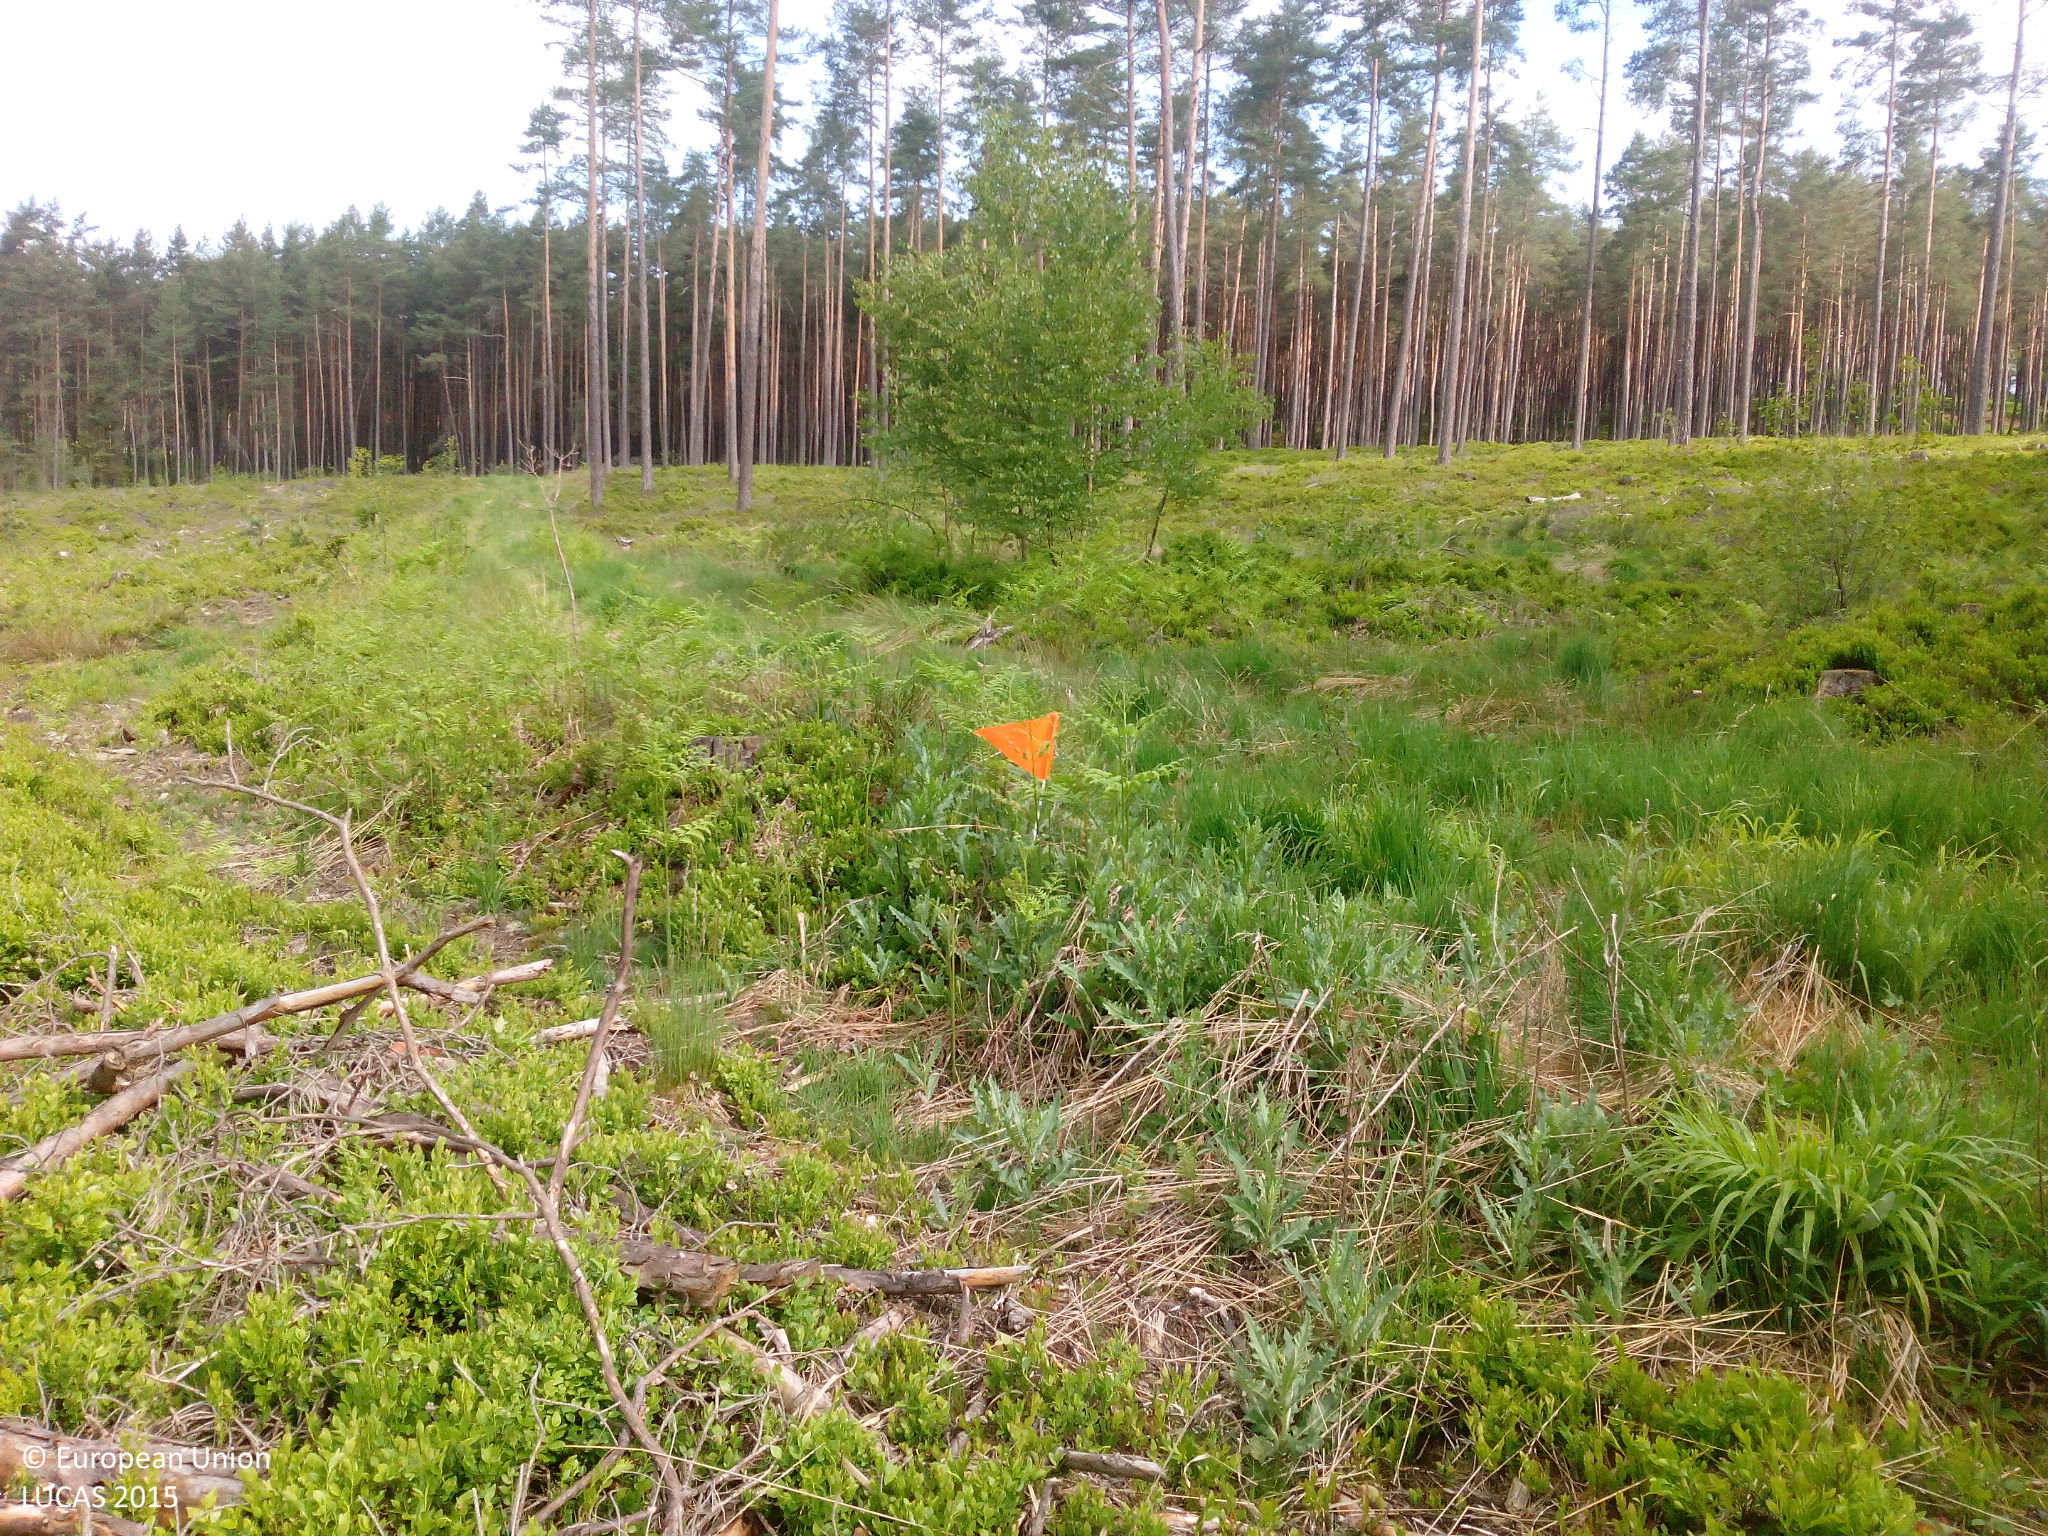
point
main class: Shrubland
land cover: Shrubland without tree cover
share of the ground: 50 - 75 %
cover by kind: shrubs 70 %, herbaceous plants 25 %, unconsolidated bare surface 5 %
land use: Forestry
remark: Clear cut
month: May
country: DE
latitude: 49.7961
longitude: 11.5416
